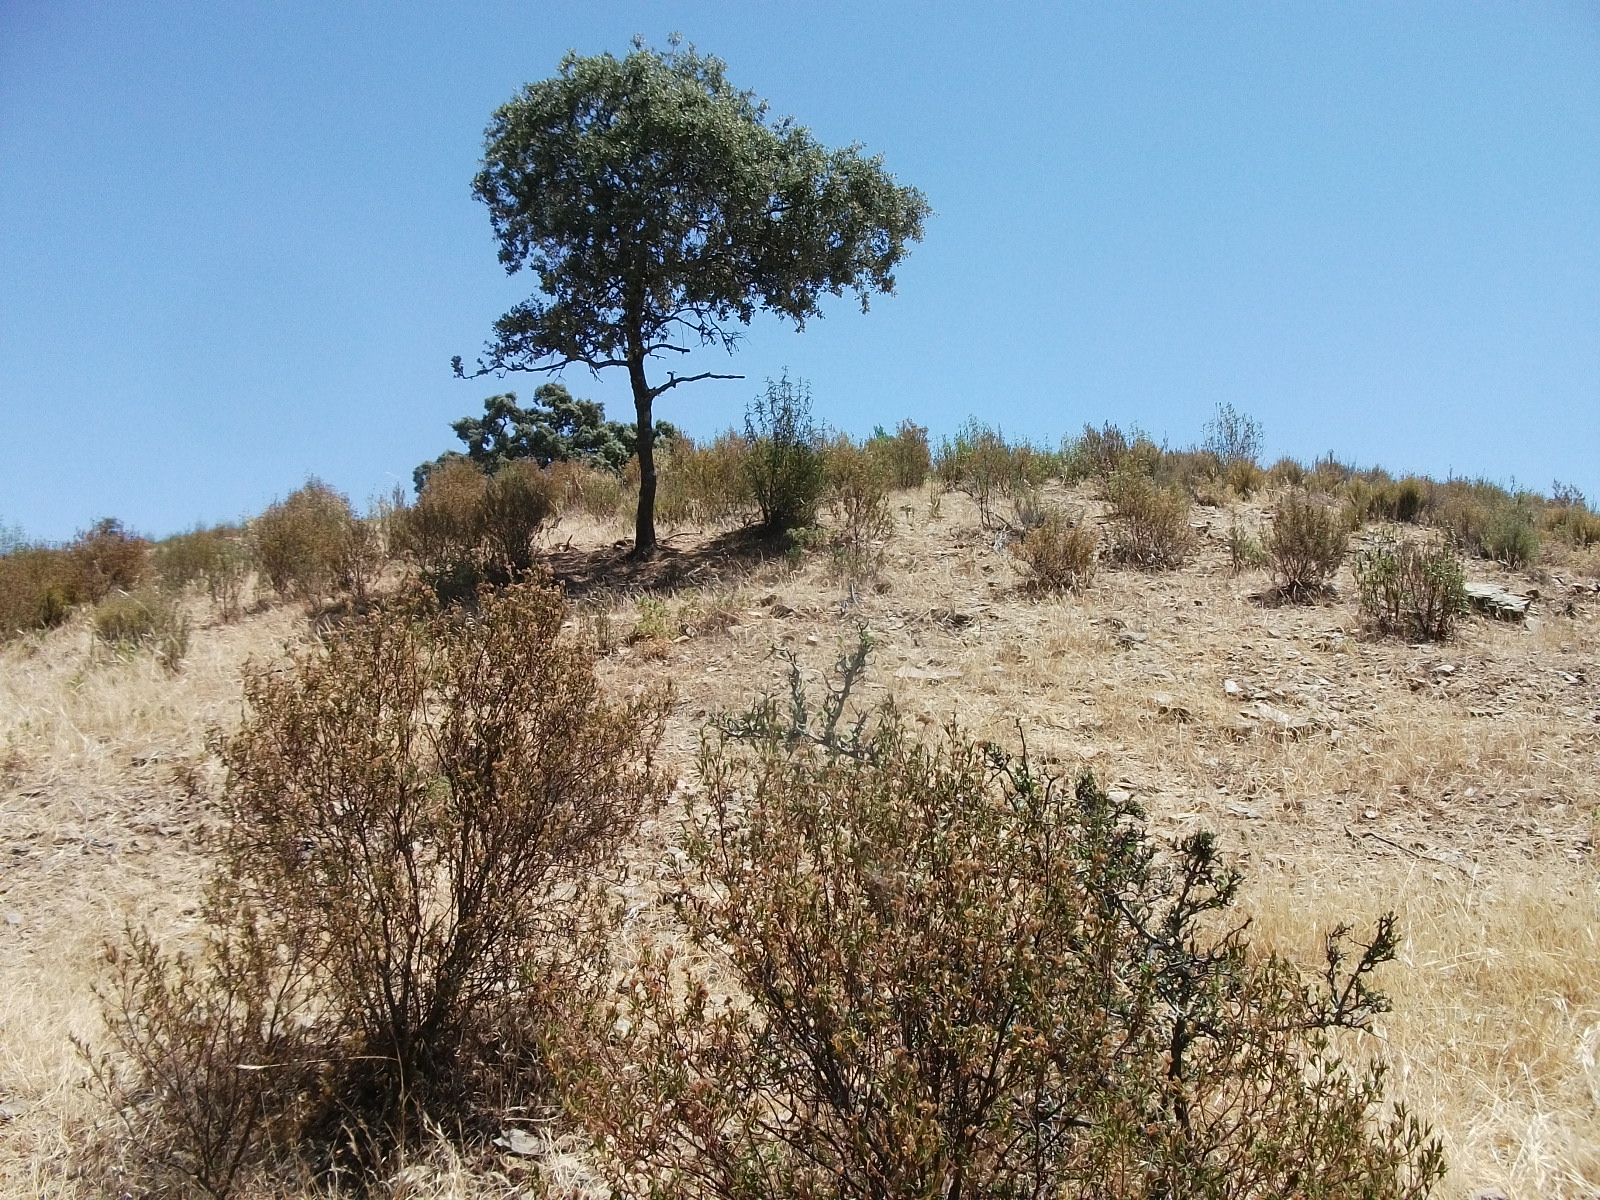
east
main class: Shrubland
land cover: Shrubland without tree cover
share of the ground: 25 - 50 %
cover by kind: shrubs 45 %, herbaceous plants 40 %, unconsolidated bare surface 15 %
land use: Agriculture (excluding fallow land and kitchen gardens)
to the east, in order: Shrubland without tree cover; Single bushes/trees; Shrubland without tree cover; Grass margins; Tracks; Grass margins; Shrubland without tree cover
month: June
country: ES
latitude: 37.5670
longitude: -6.9246
